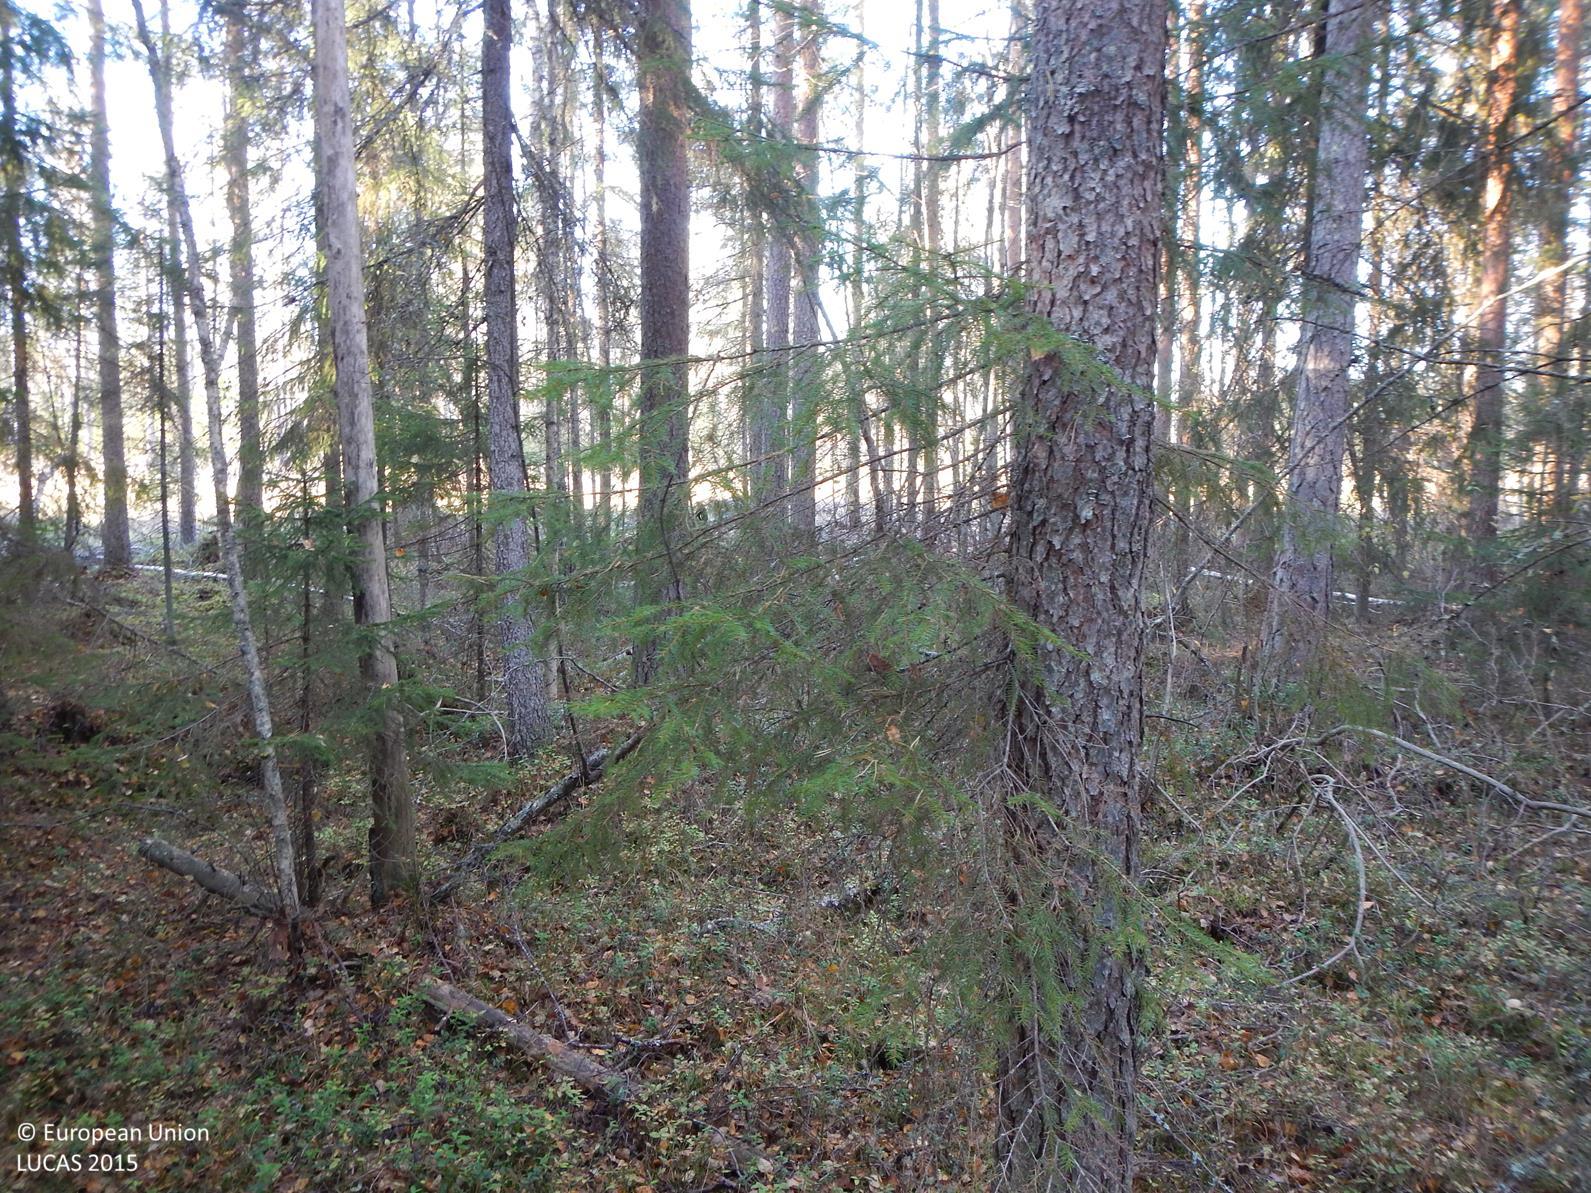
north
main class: Woodland
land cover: Other mixed woodland
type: boreal forest
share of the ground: > 75 %
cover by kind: coniferous forest trees 60 %, broadleaved forest trees 25 %, shrubs 5 %, lichens and mosses 5 %, unconsolidated bare surface 5 %
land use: Forestry
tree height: > 5 m
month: October
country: FI
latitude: 61.9194
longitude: 25.9538
